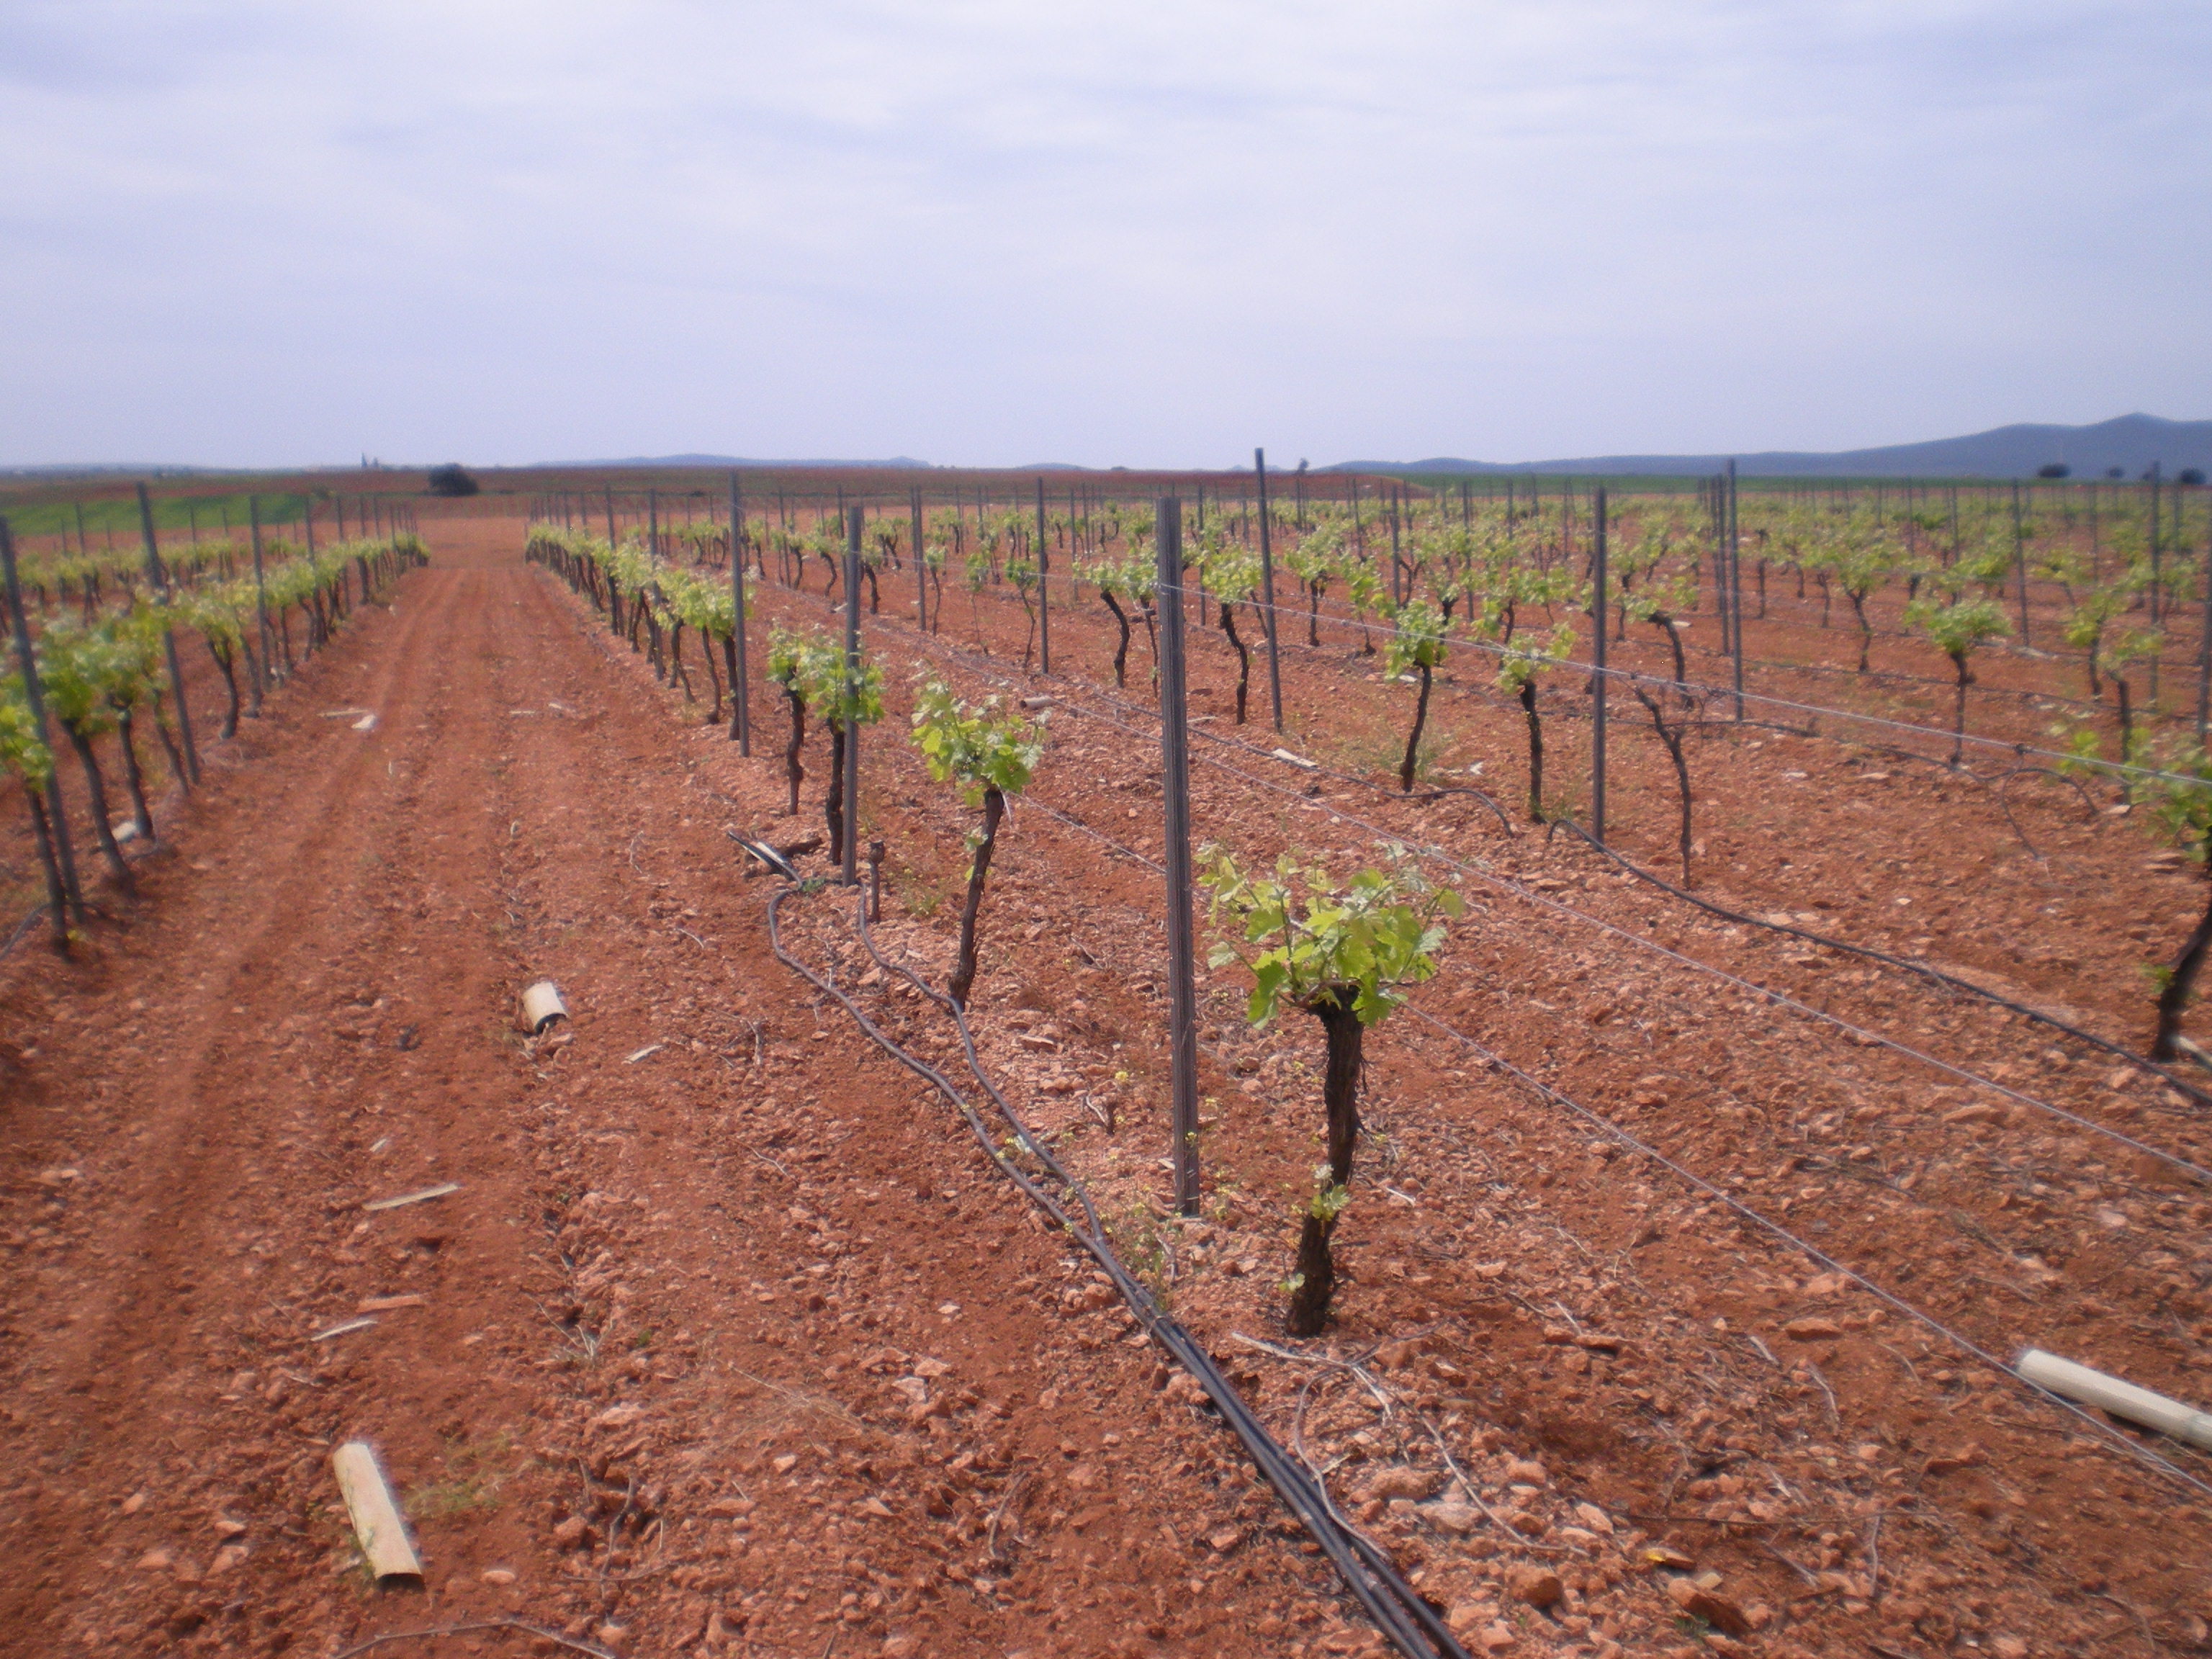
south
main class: Cropland
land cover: Vineyards
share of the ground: < 10 %
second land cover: Other bare soil
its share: > 75 %
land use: Agriculture (excluding fallow land and kitchen gardens)
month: May
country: ES
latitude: 38.7182
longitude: -3.1538
